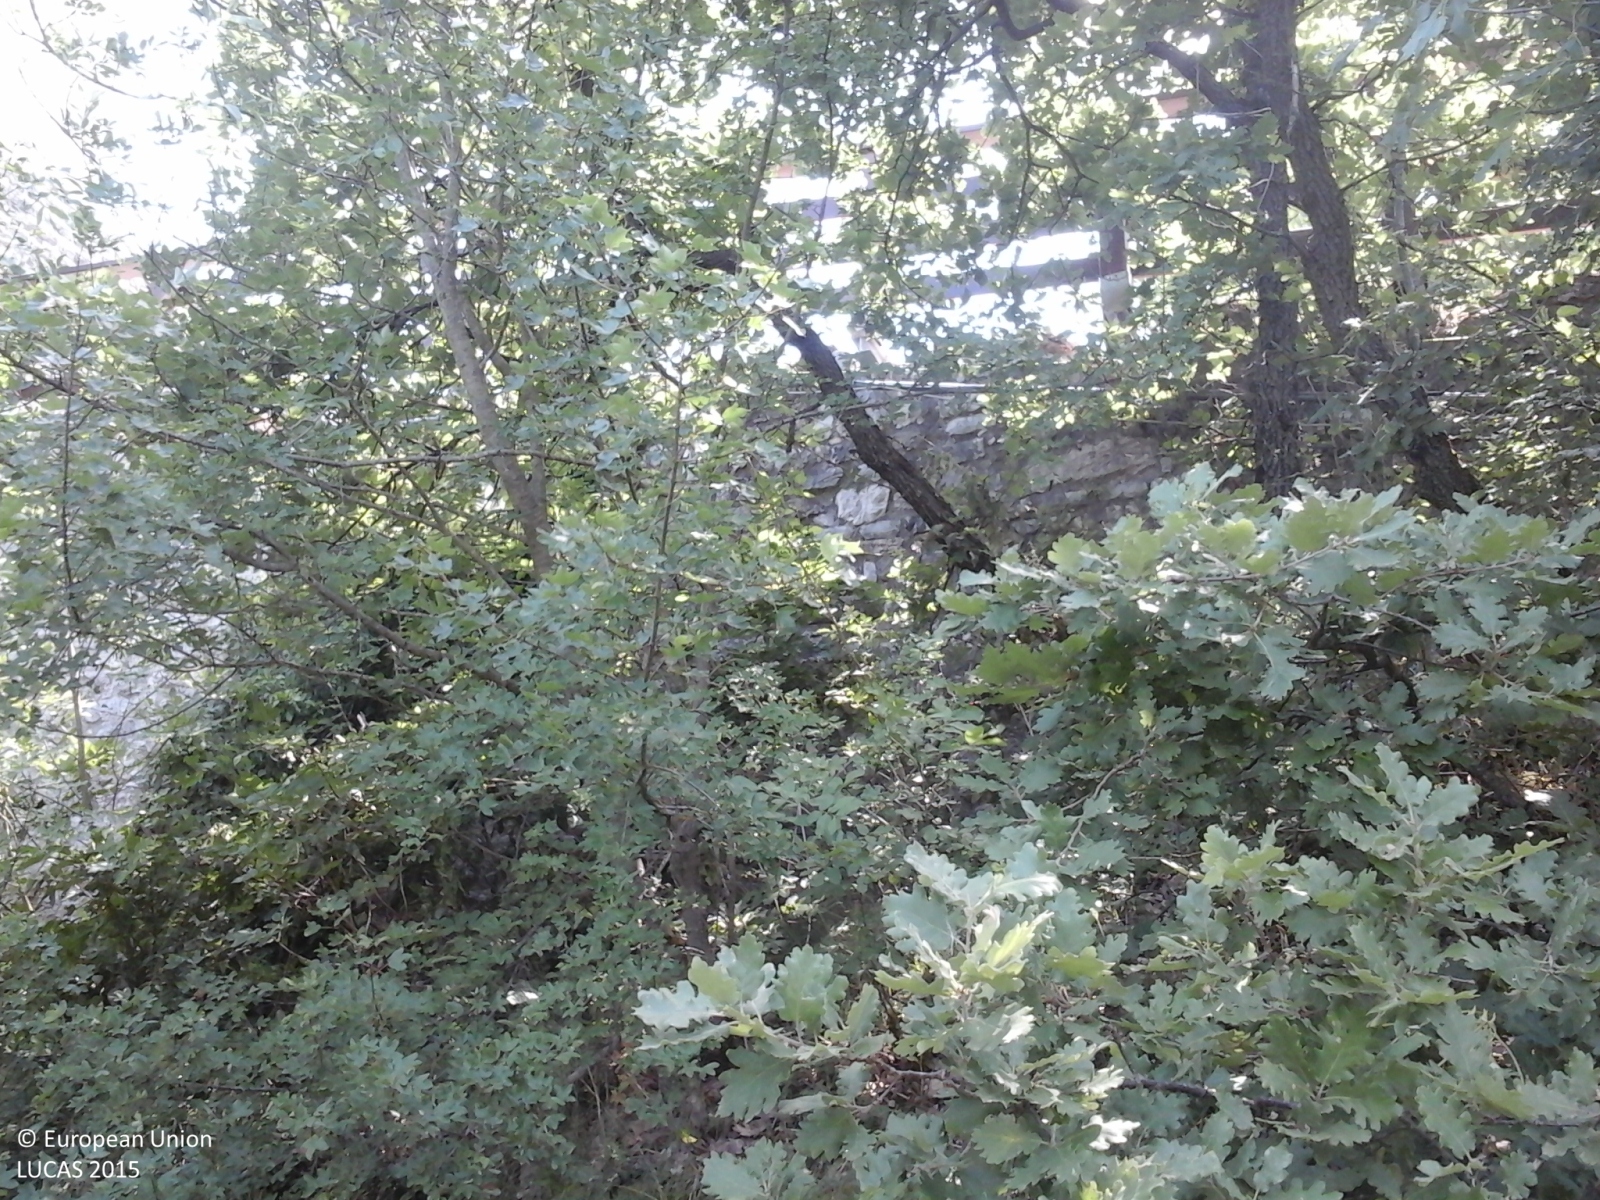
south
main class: Woodland
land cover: Broadleaved woodland
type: thermophilous deciduous forest
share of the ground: > 75 %
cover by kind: broadleaved forest trees 95 %, herbaceous plants 5 %
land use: Forestry
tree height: < 5 m
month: June
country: IT
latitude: 43.1118
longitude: 13.1251
